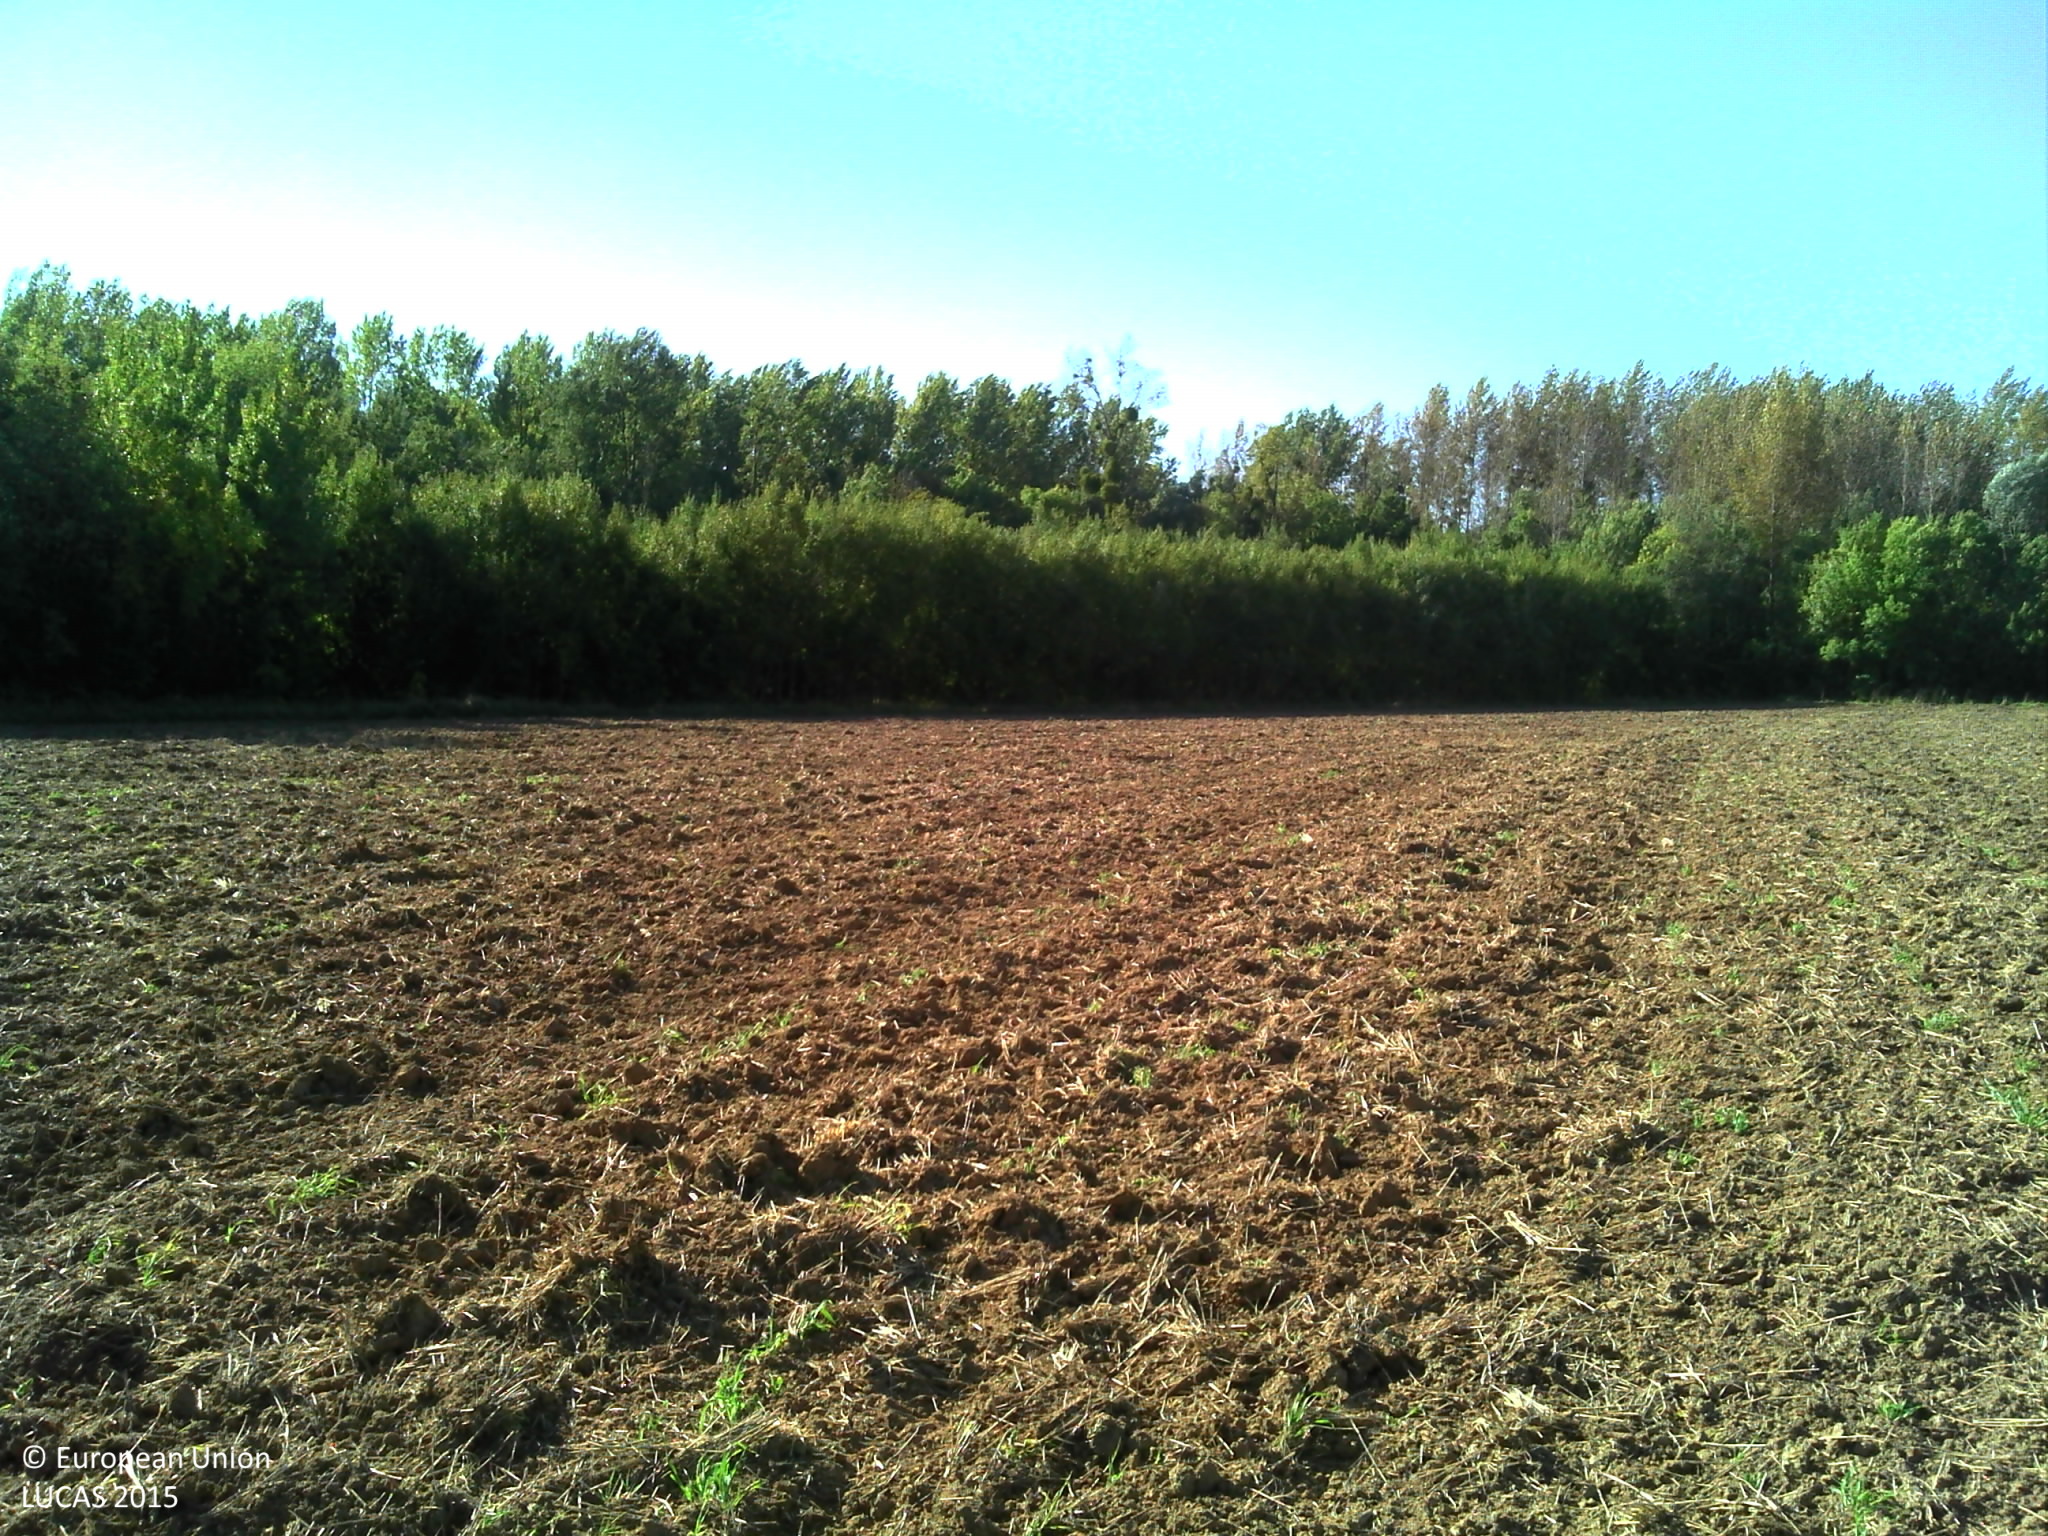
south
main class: Cropland
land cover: Common wheat
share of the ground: < 10 %
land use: Agriculture (excluding fallow land and kitchen gardens)
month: September
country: FR
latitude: 48.4220
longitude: 3.3858
